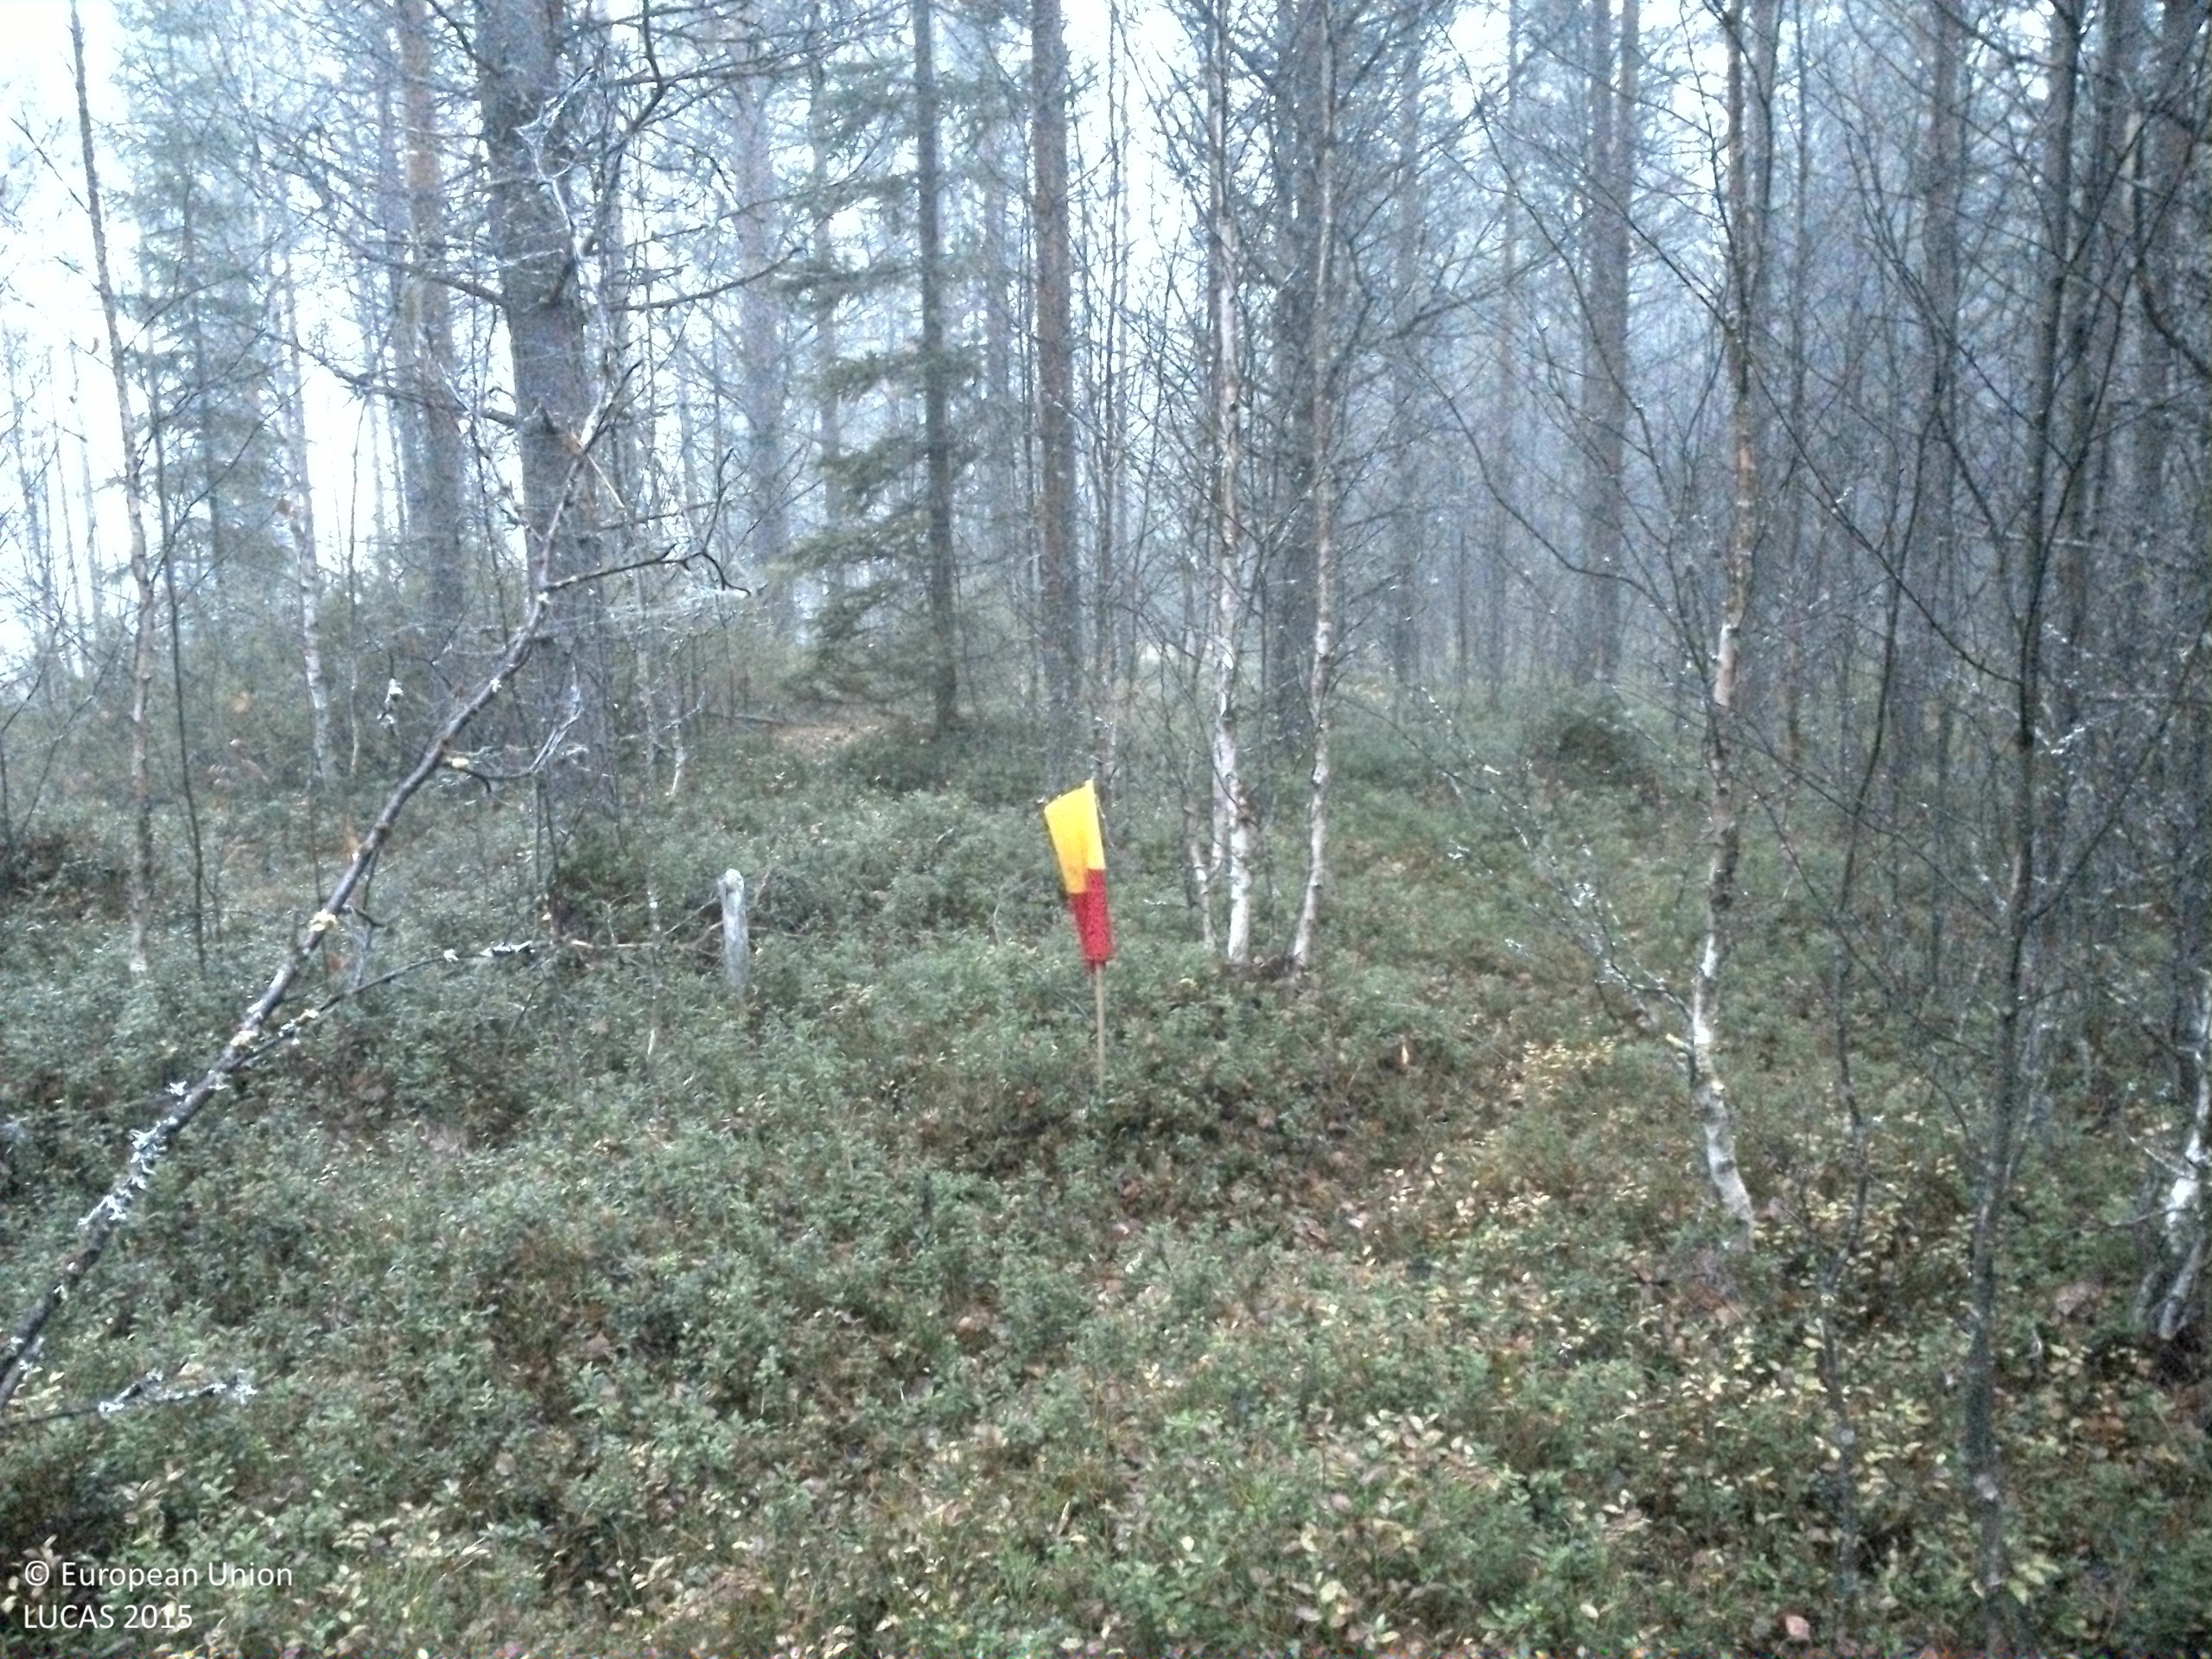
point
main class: Woodland
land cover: Pine dominated mixed woodland
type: boreal forest
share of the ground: 50 - 75 %
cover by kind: coniferous forest trees 45 %, shrubs 30 %, broadleaved forest trees 15 %, lichens and mosses 10 %
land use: Forestry
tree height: > 5 m
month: October
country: SE
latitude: 64.0915
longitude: 16.3091
